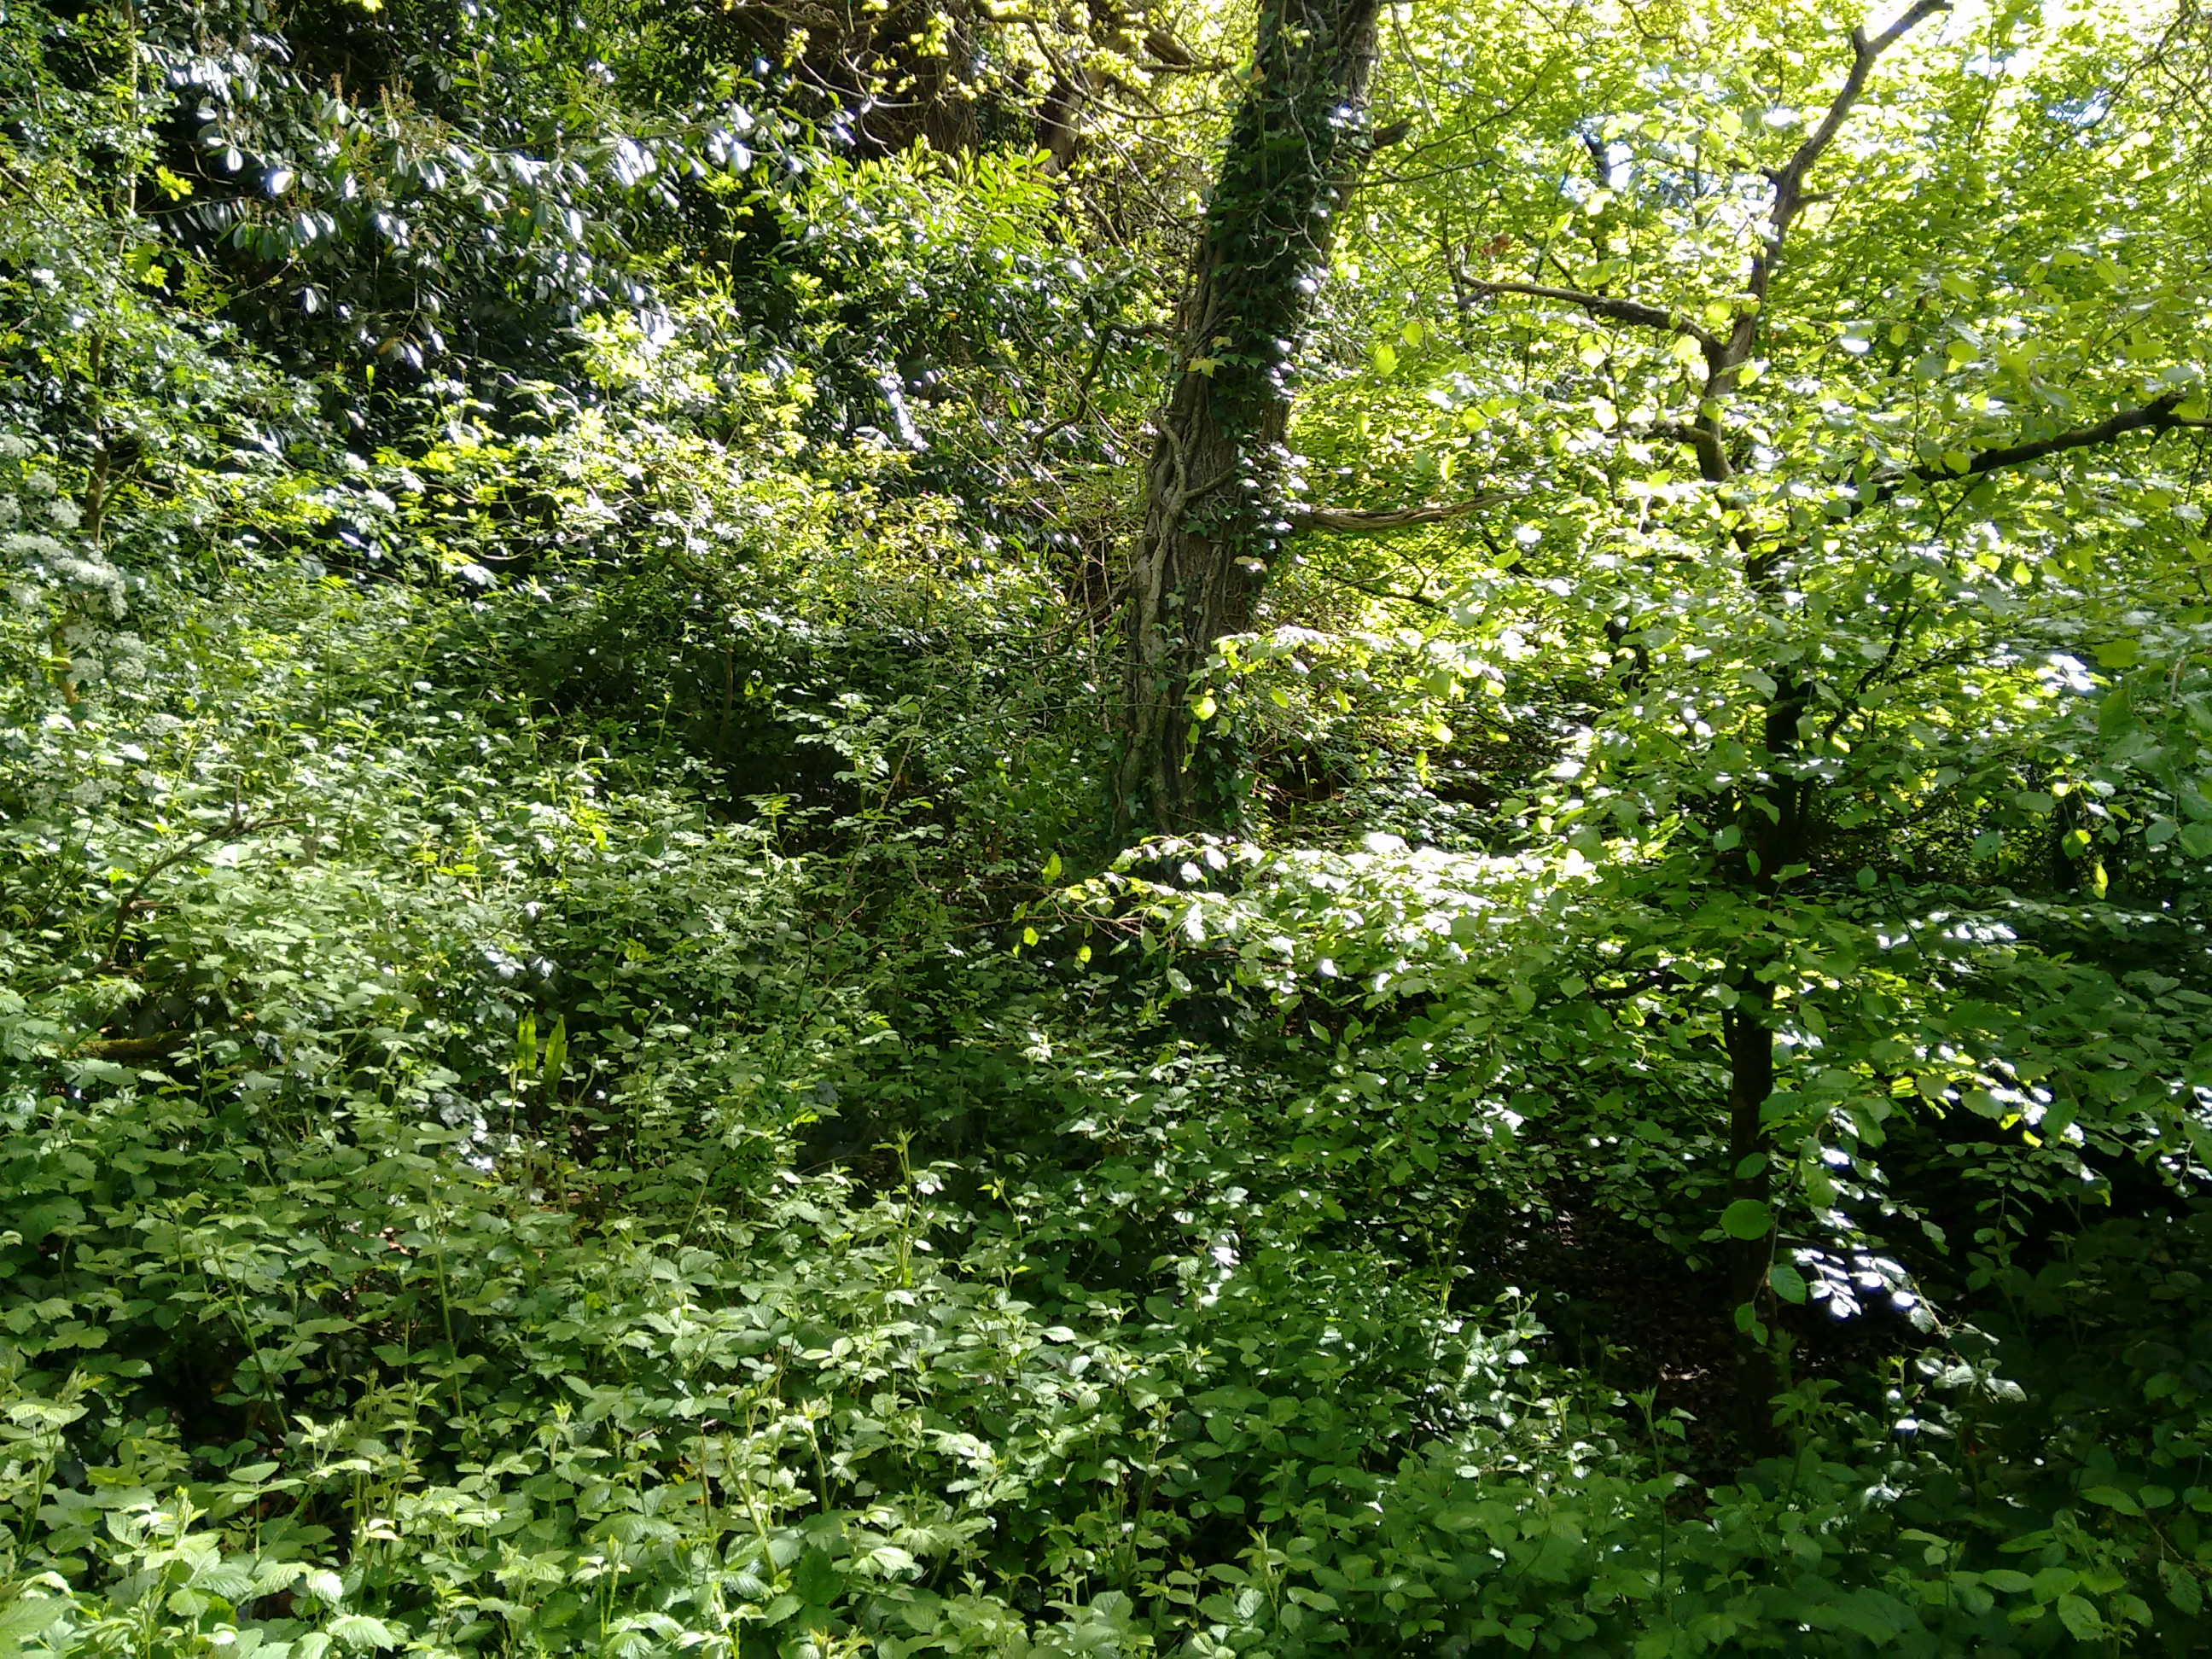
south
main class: Woodland
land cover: Broadleaved woodland
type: beech forest
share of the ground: > 75 %
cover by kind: broadleaved forest trees 85 %, shrubs 10 %, herbaceous plants 5 %
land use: Semi-natural and natural areas not in use
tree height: > 5 m
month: May
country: IE
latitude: 53.5901
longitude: -6.7056
